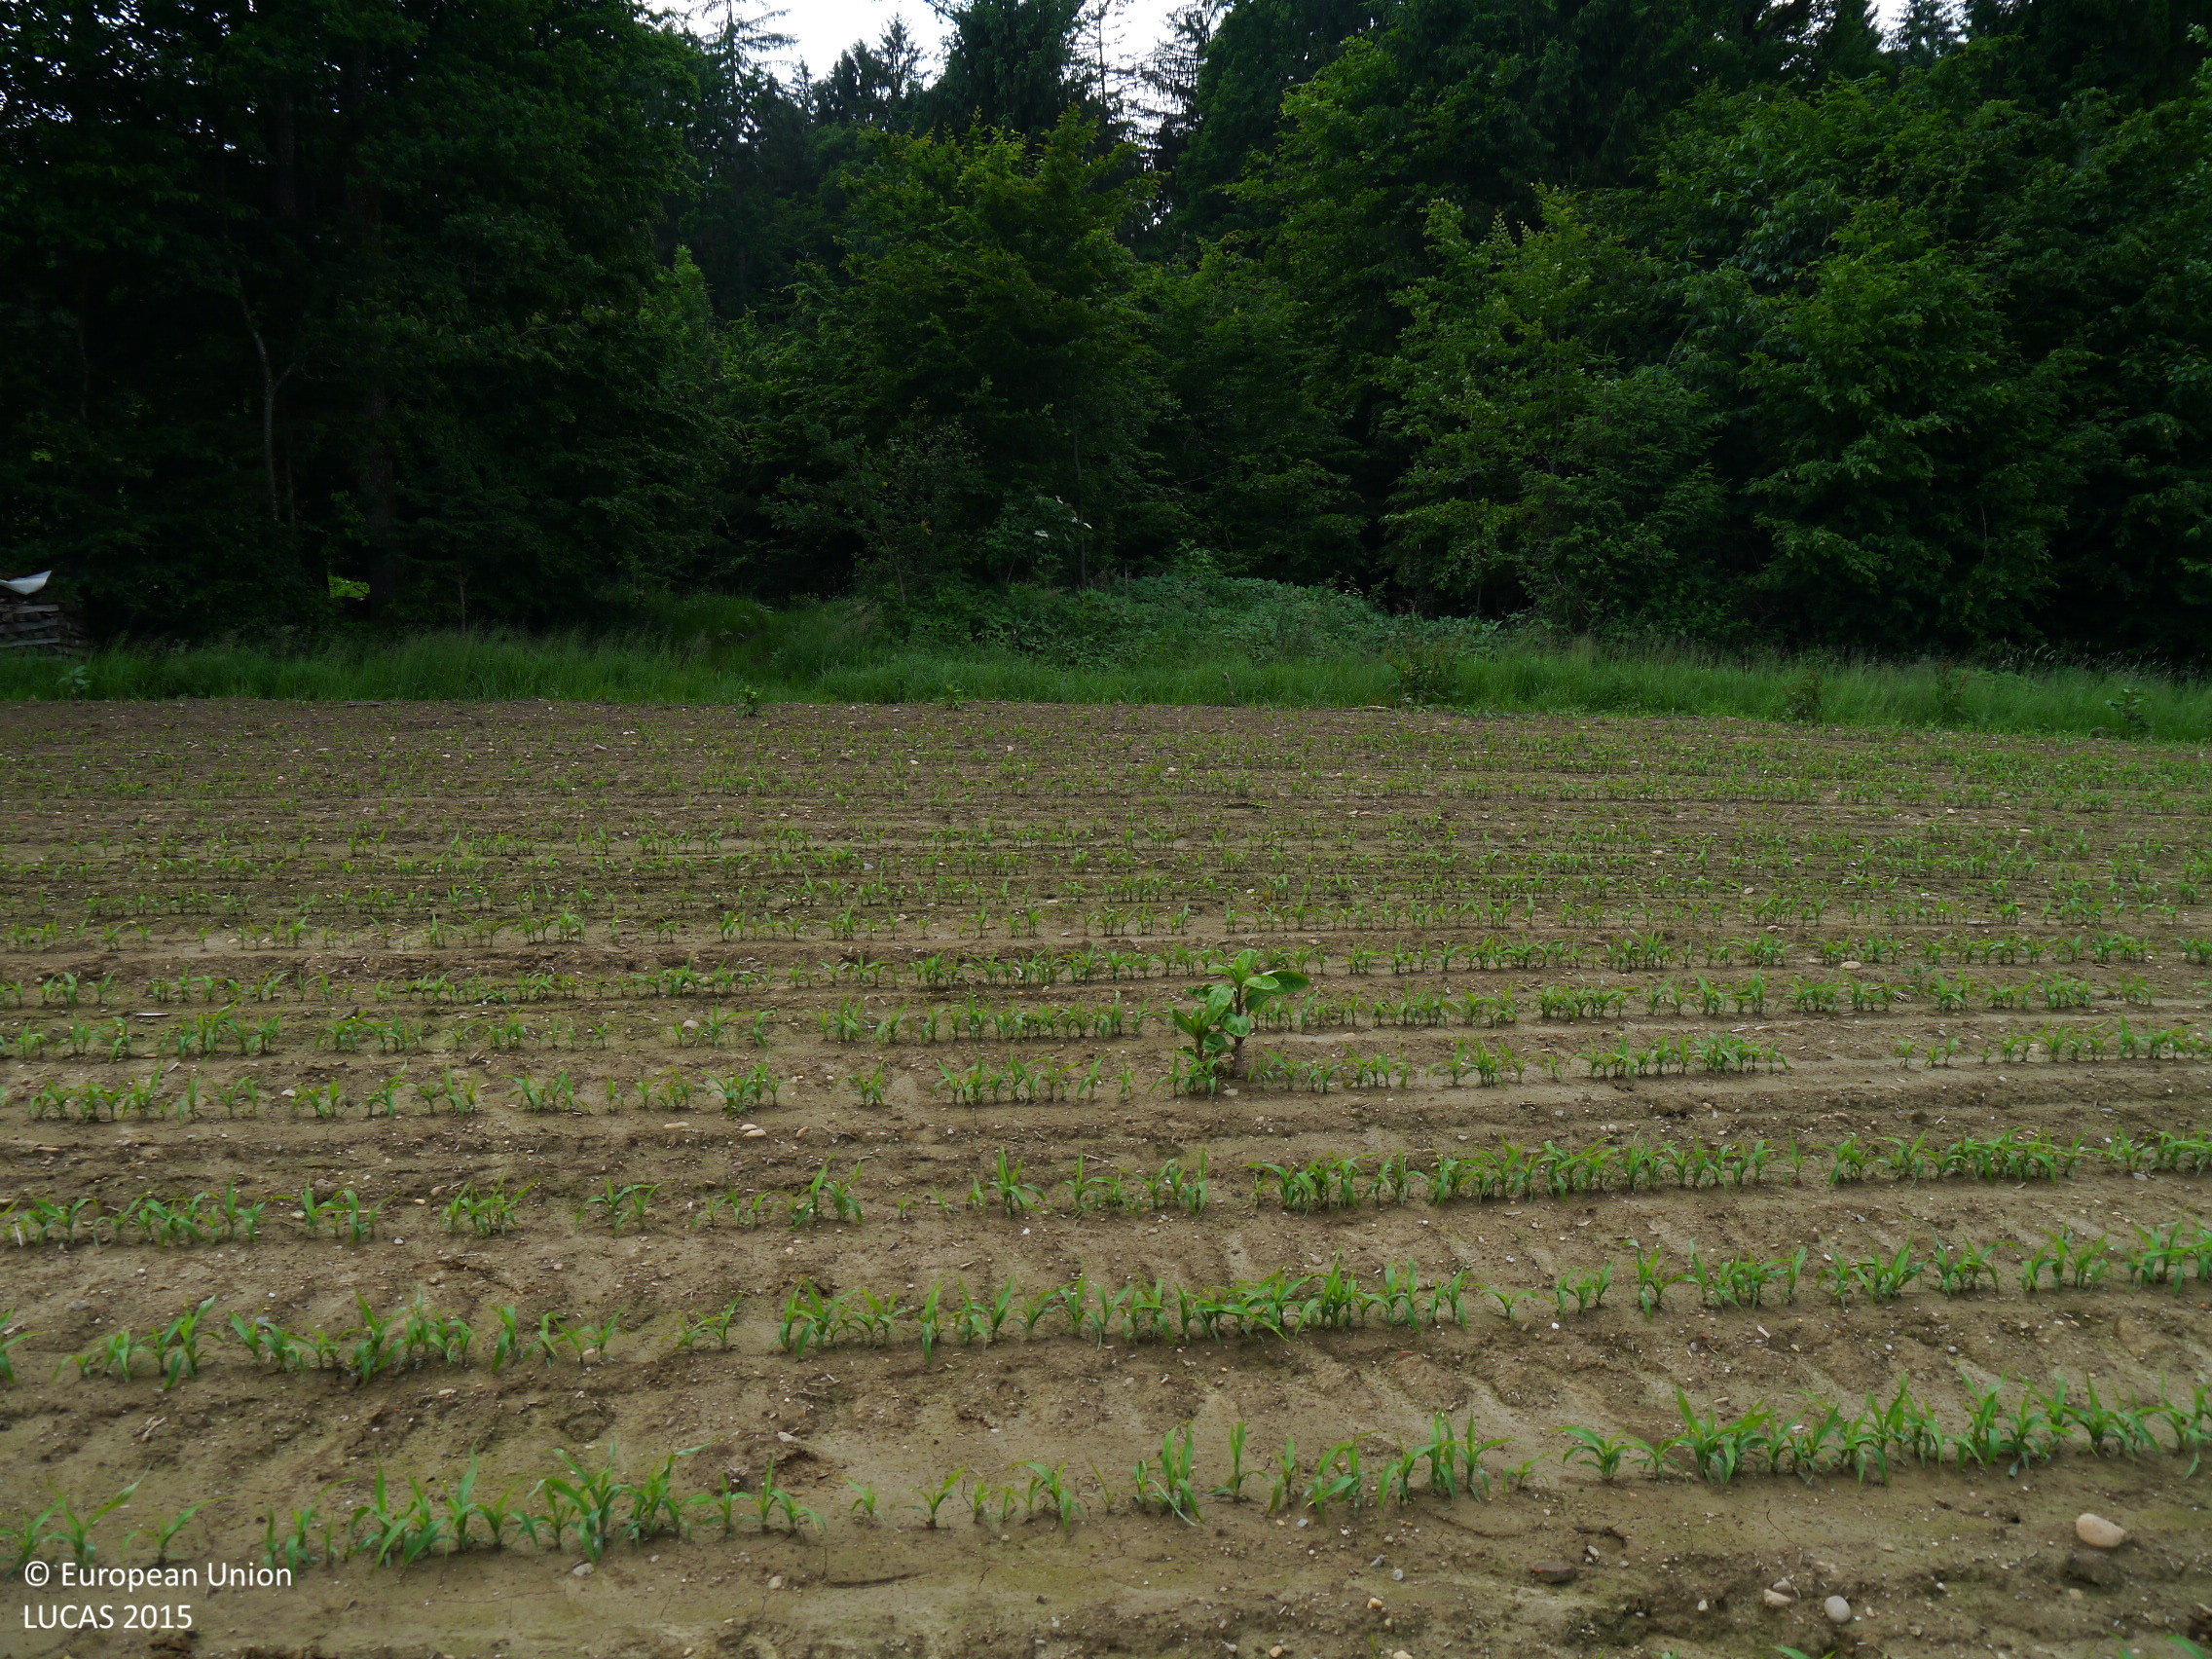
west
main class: Cropland
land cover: Maize
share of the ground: 10 - 25 %
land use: Agriculture (excluding fallow land and kitchen gardens)
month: June
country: AT
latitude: 46.8889
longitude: 15.6301
